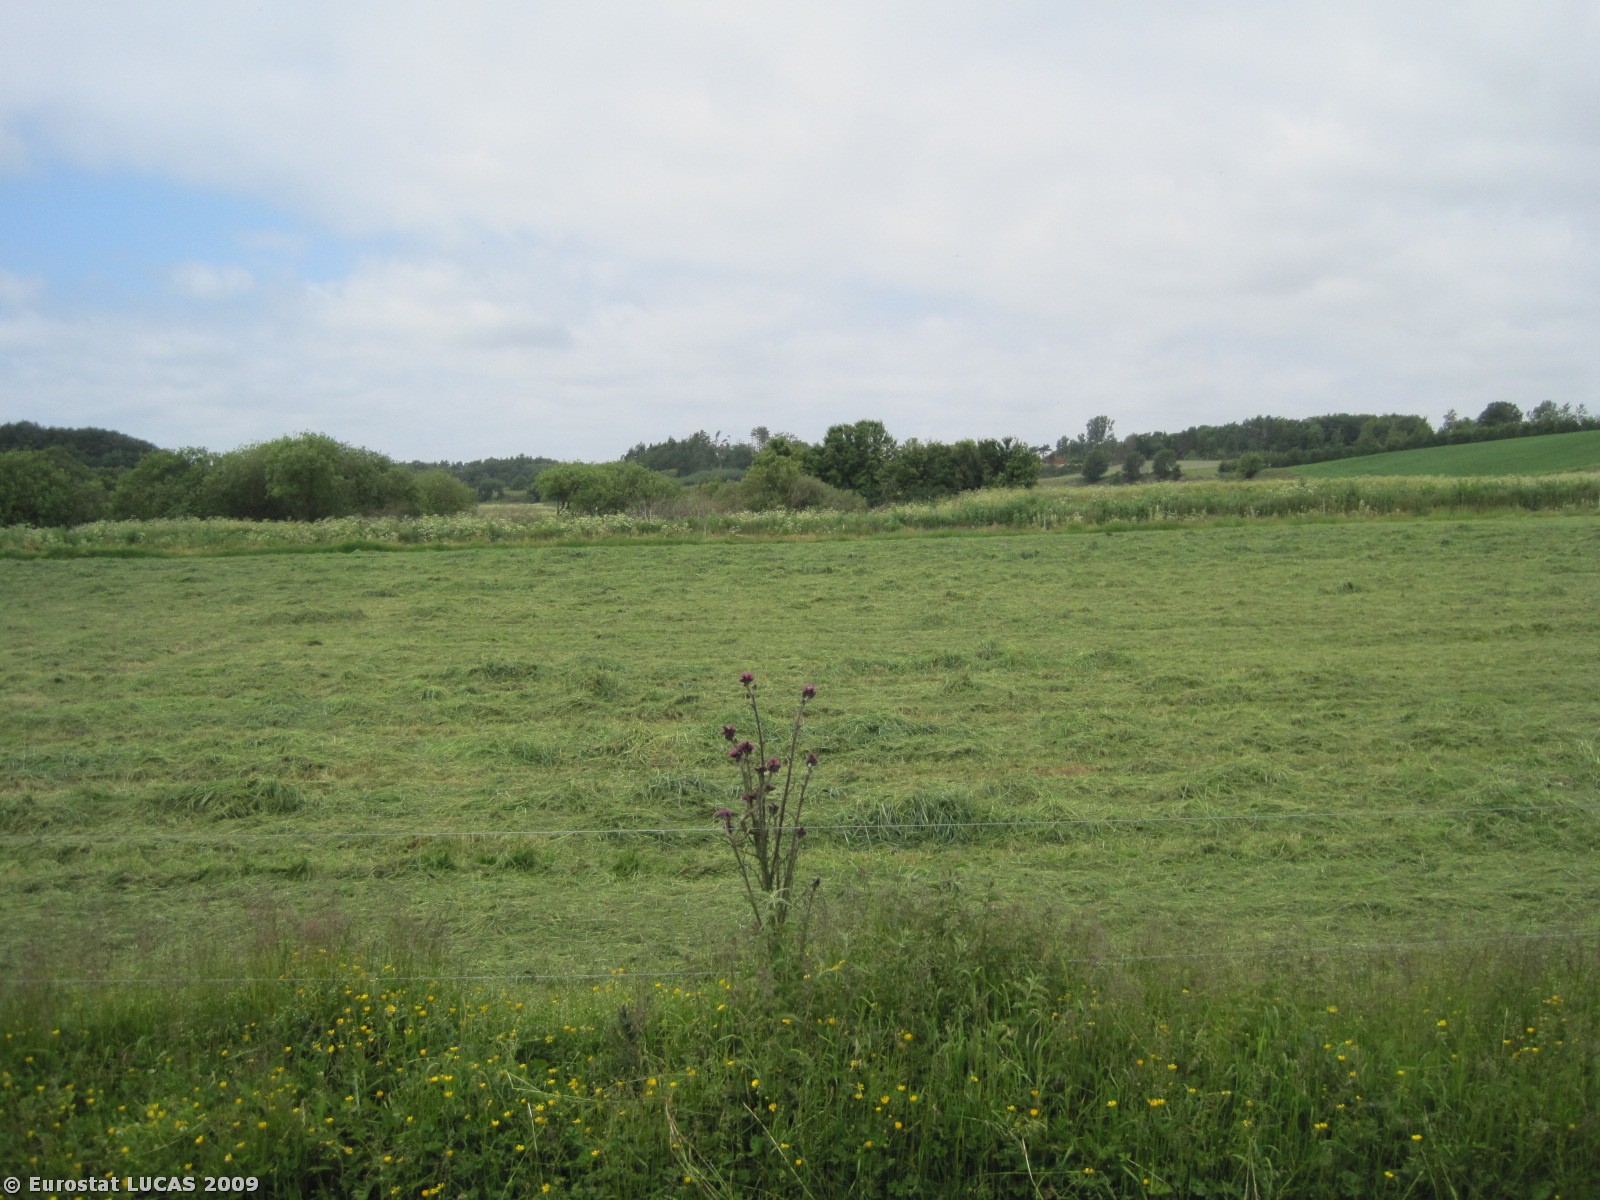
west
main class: Grassland
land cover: Grassland without tree/shrub cover
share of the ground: > 75 %
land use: Agriculture (excluding fallow land and kitchen gardens)
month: June
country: DK
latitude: 57.2483
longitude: 10.1489
